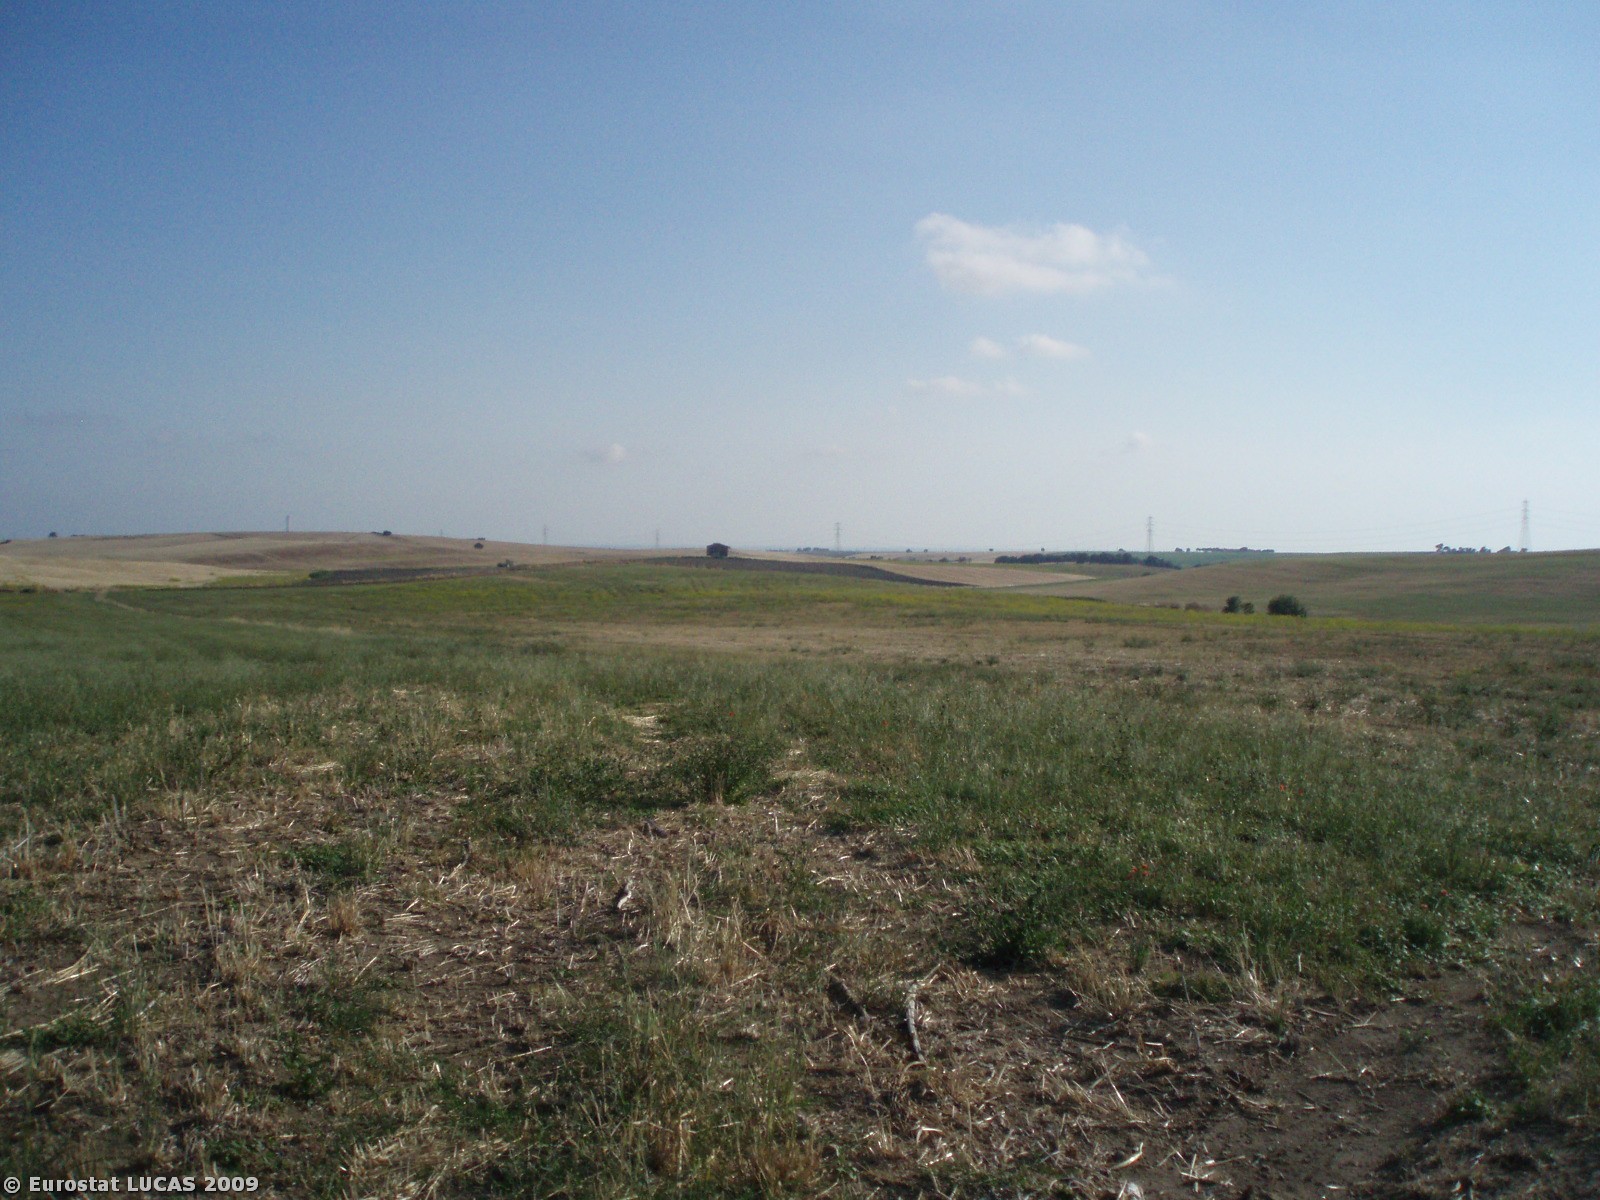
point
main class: Cropland
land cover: Temporary grasslands
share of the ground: > 75 %
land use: Agriculture (excluding fallow land and kitchen gardens)
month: June
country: IT
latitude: 42.4429
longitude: 11.5871
